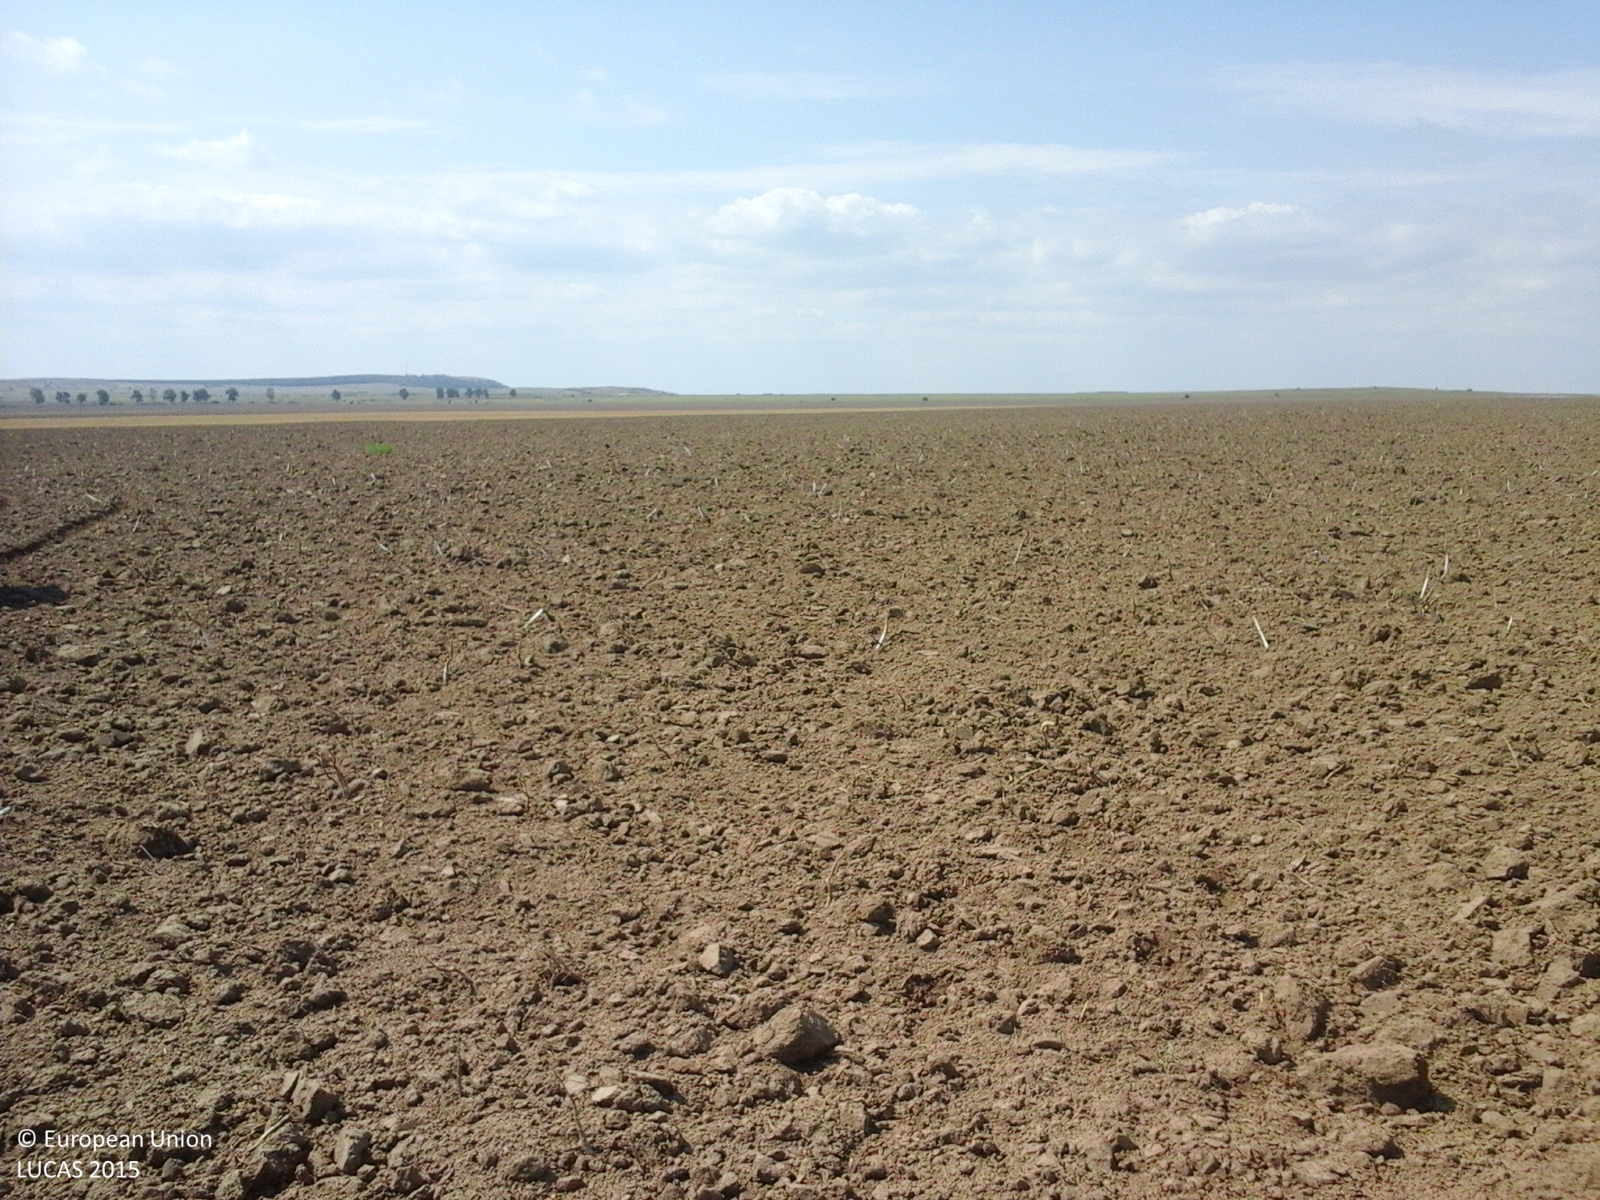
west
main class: Cropland
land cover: Rape and turnip rape
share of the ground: < 10 %
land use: Agriculture (excluding fallow land and kitchen gardens)
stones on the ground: < 10 %
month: August
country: RO
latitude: 44.8311
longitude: 28.8986
